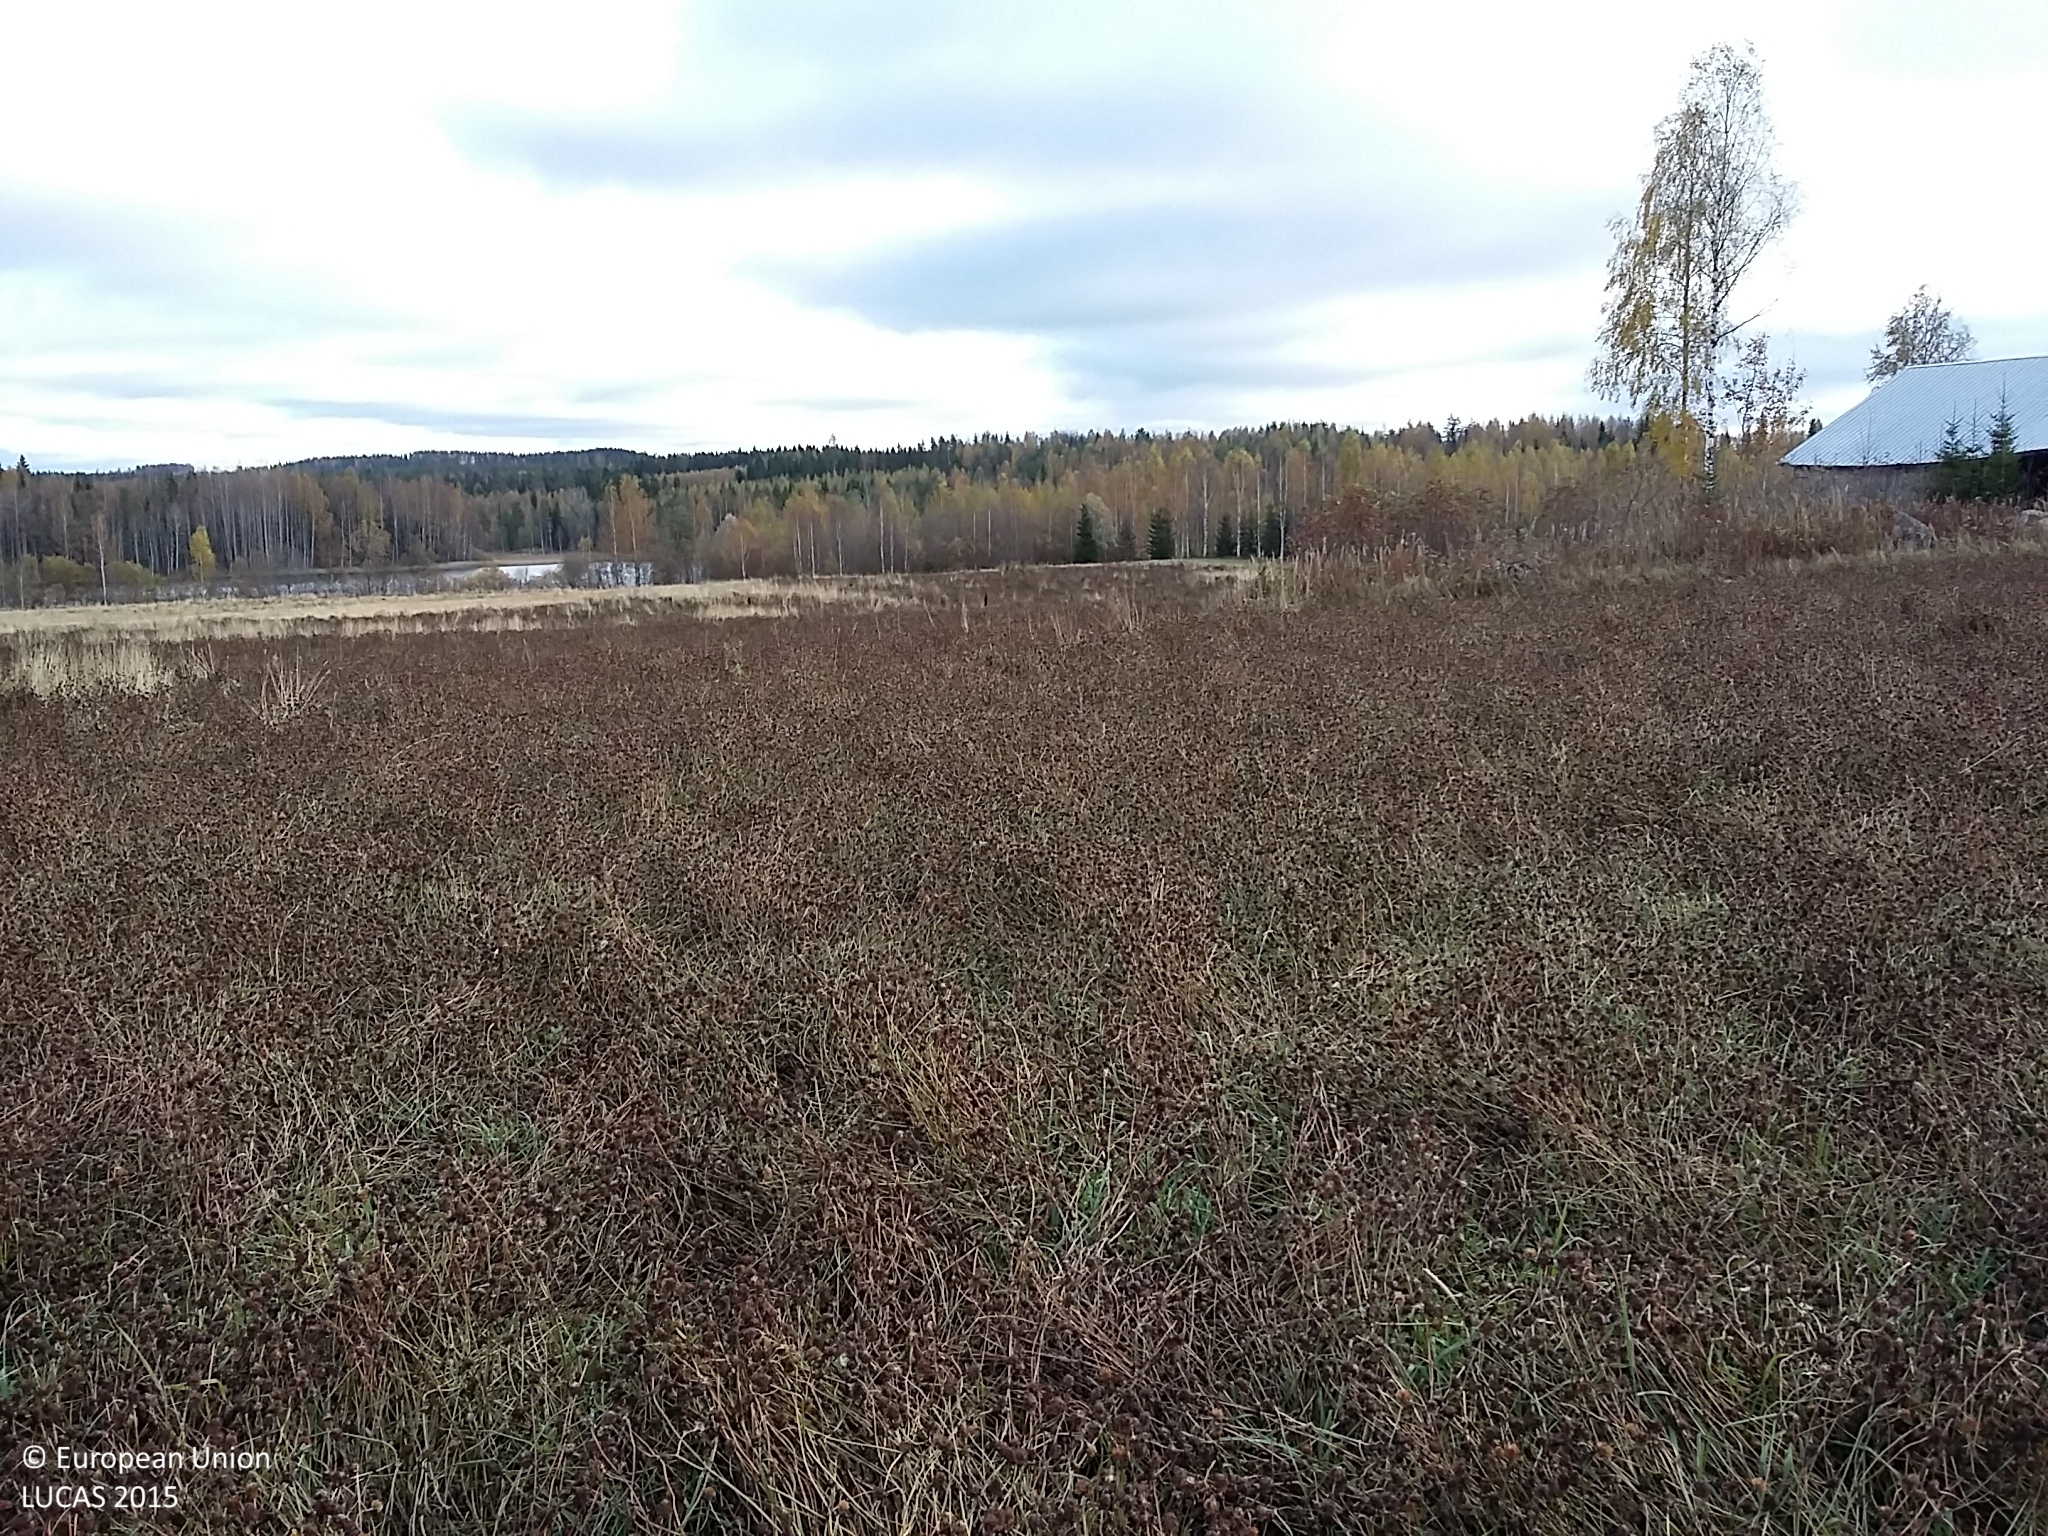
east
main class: Cropland
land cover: Other leguminous and mixtures for fodder
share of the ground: > 75 %
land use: Agriculture (excluding fallow land and kitchen gardens)
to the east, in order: Other leguminous and mixtures for fodder; Temporary grasslands; Broadleaved woodland
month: October
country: FI
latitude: 62.5481
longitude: 26.2891
